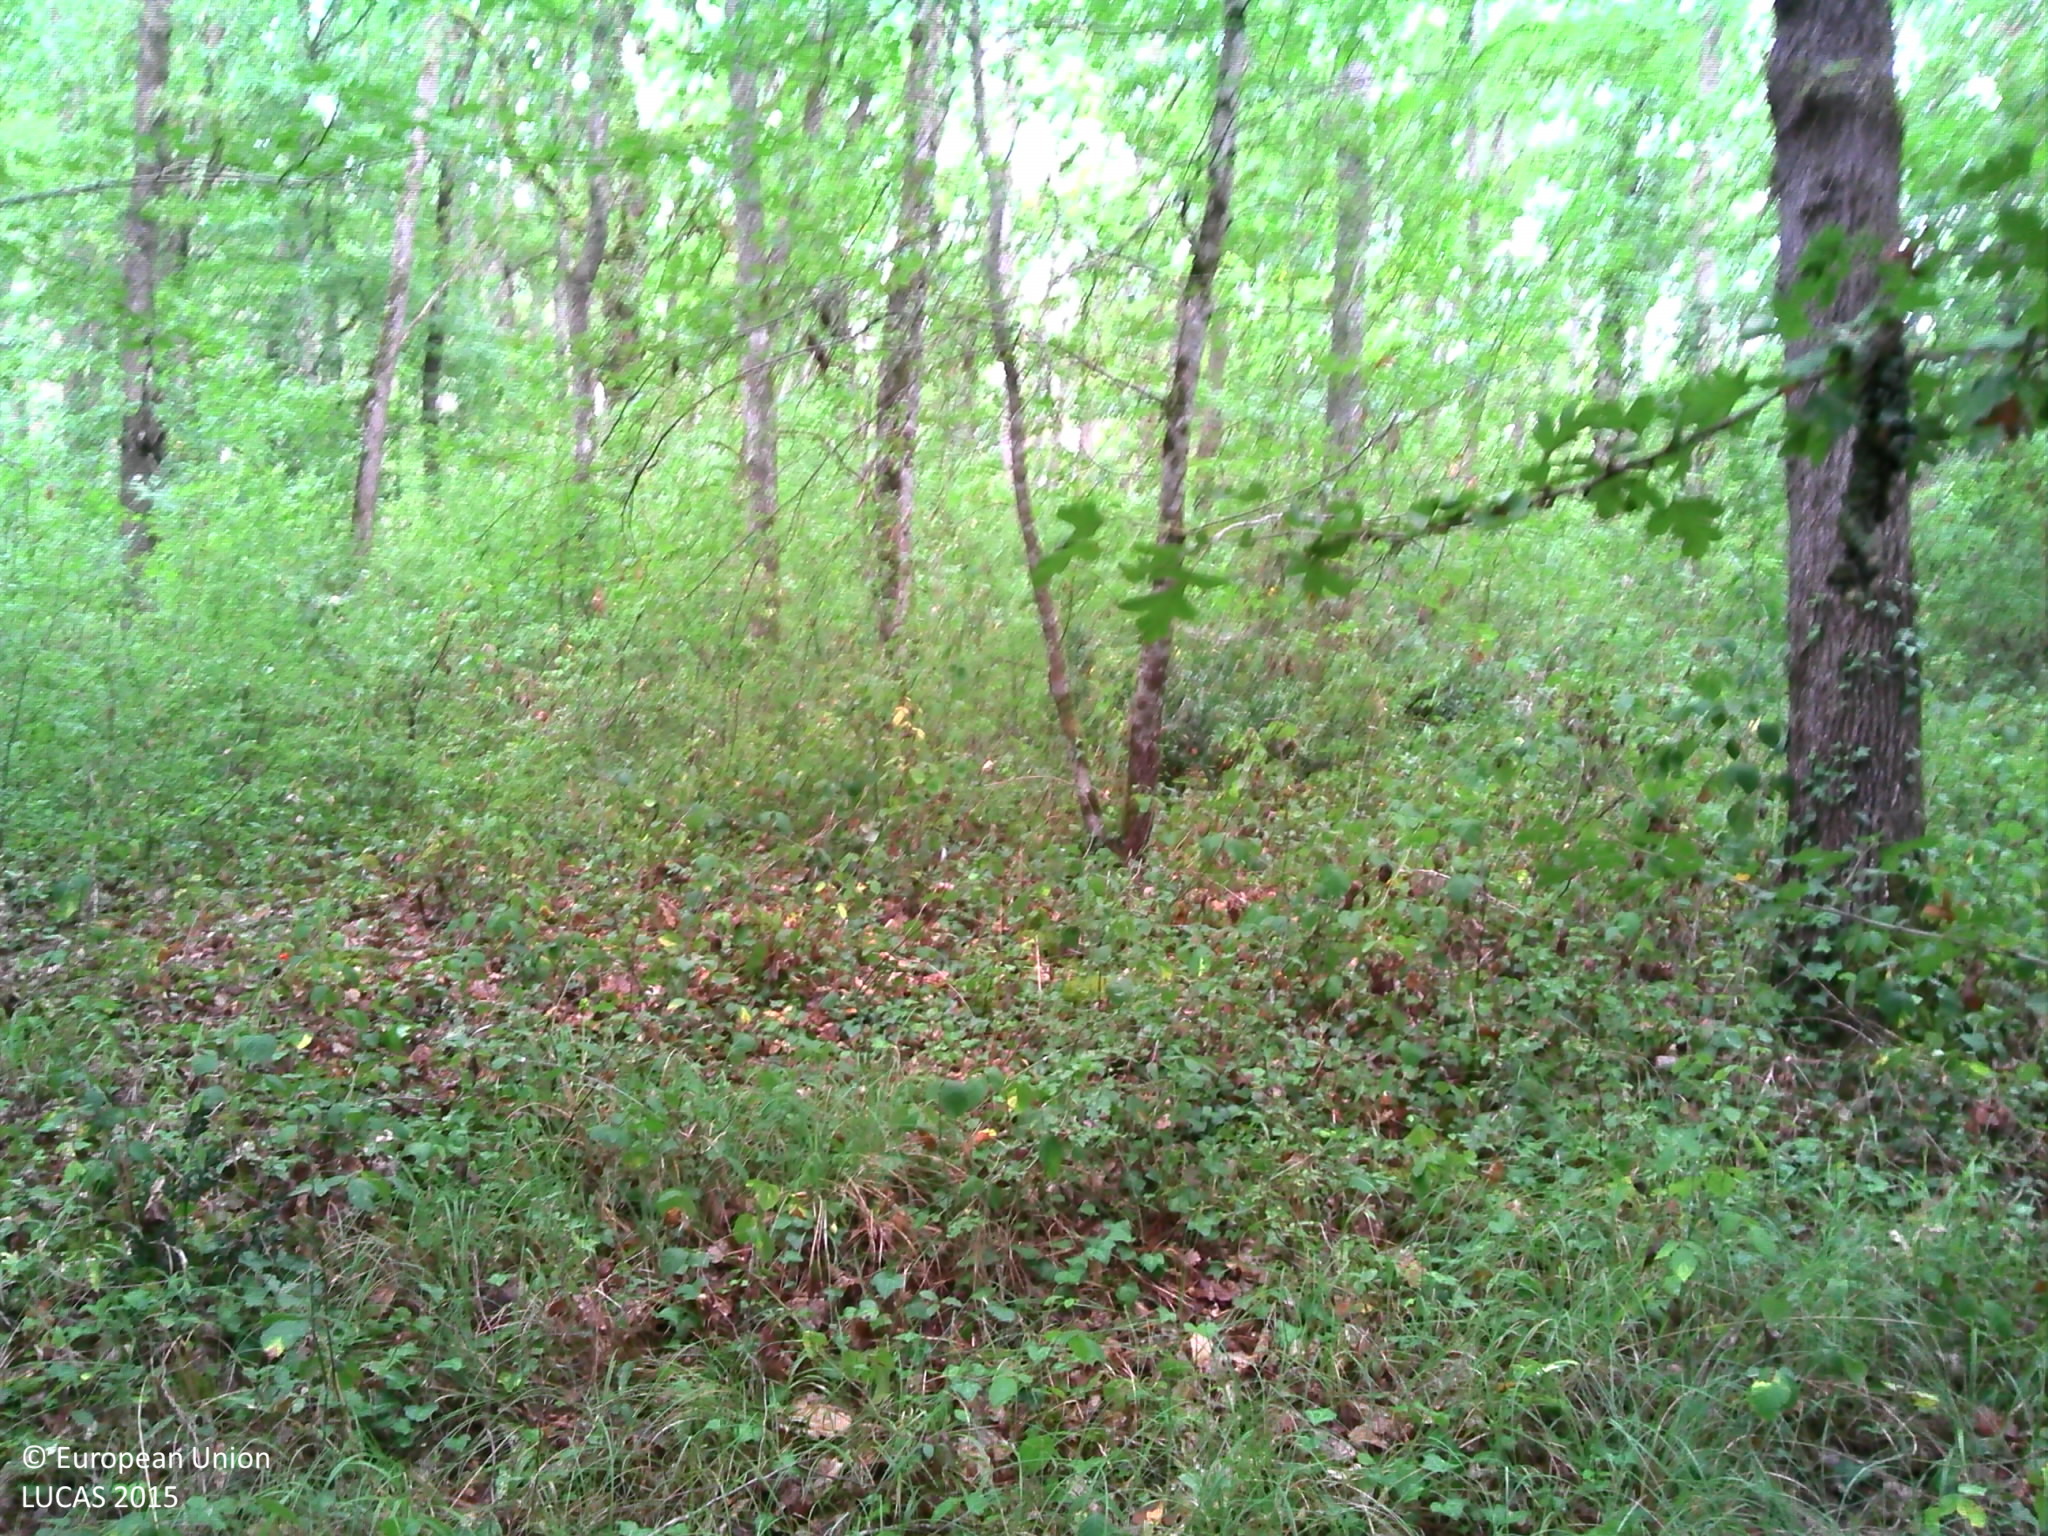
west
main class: Woodland
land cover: Broadleaved woodland
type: thermophilous deciduous forest
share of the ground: > 75 %
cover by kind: broadleaved forest trees 85 %, herbaceous plants 15 %
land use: Forestry
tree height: > 5 m
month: August
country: FR
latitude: 44.2376
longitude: 0.6667
